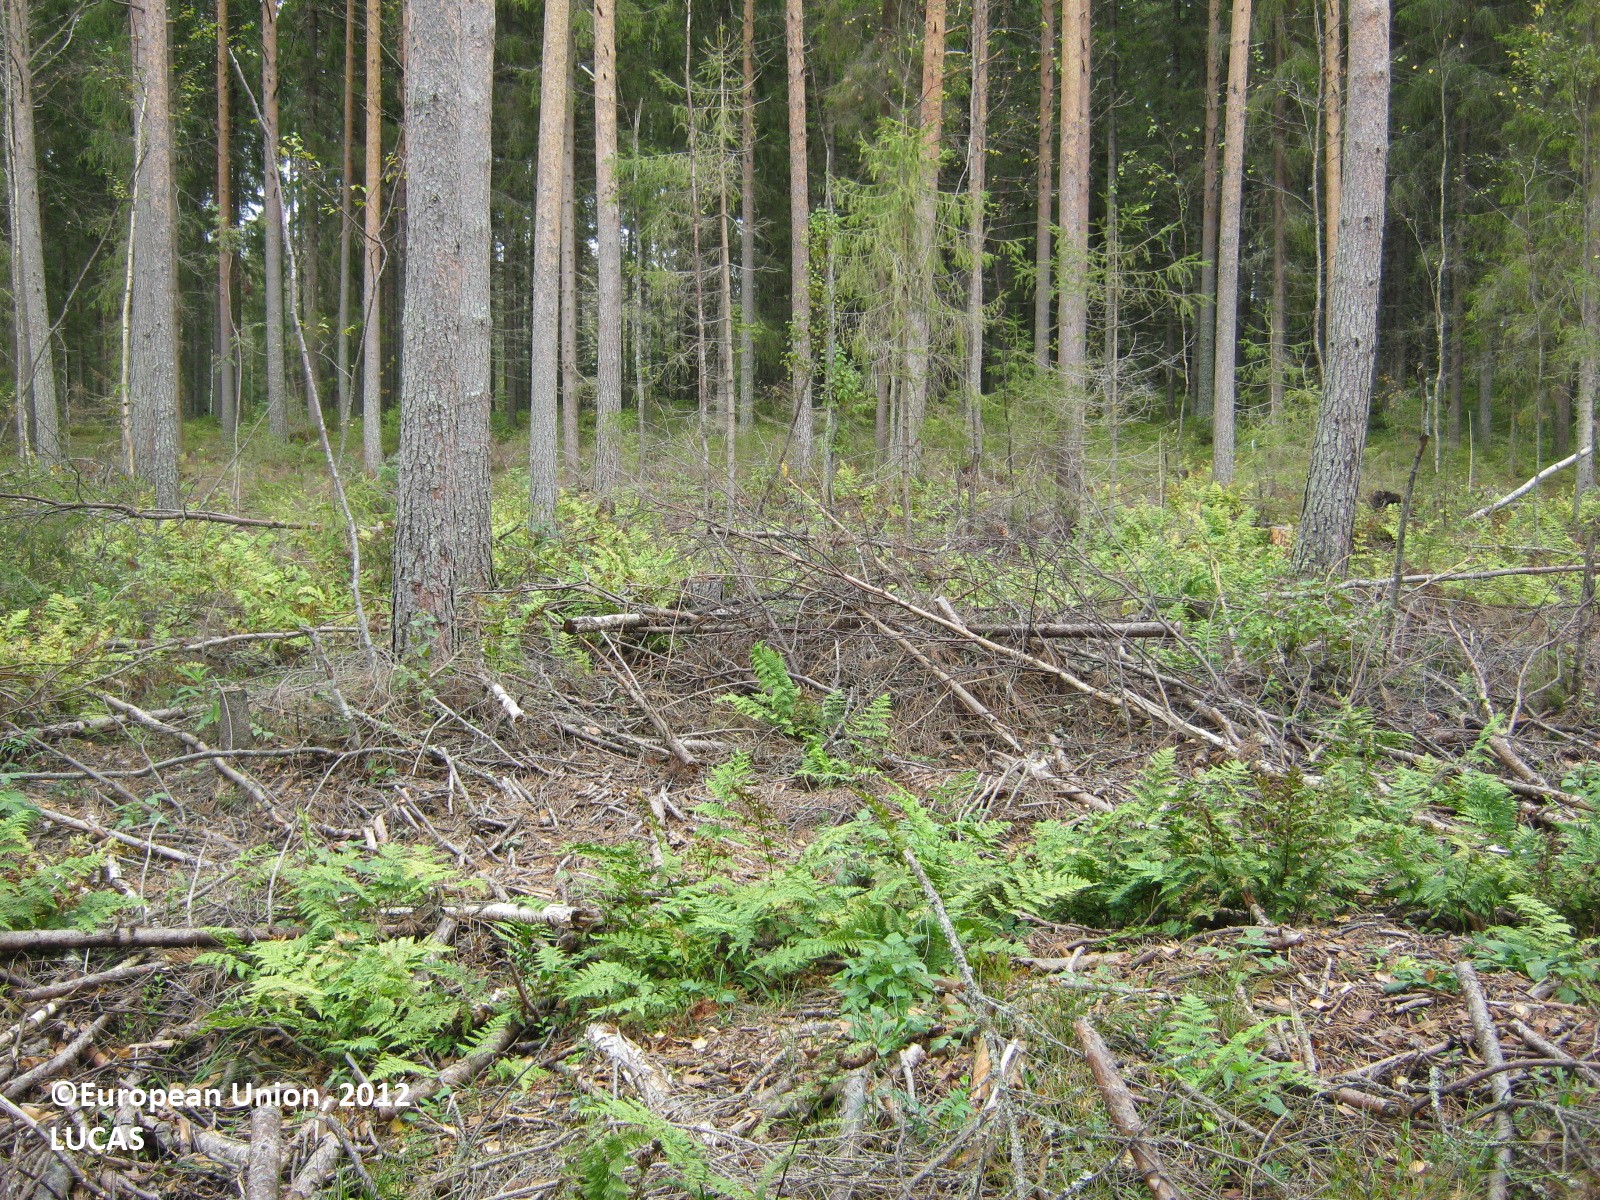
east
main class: Woodland
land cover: Other mixed woodland
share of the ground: 25 - 50 %
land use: Forestry
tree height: > 5 m
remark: Clear cut
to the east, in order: Other mixed woodland; Rivers and streams; Broadleaved woodland; Grassland without tree/shrub cover; Ditches and canals; Other mixed woodland; Electric lines; Spruce dominated mixed woodland
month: September
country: FI
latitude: 62.5715
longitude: 27.5449
